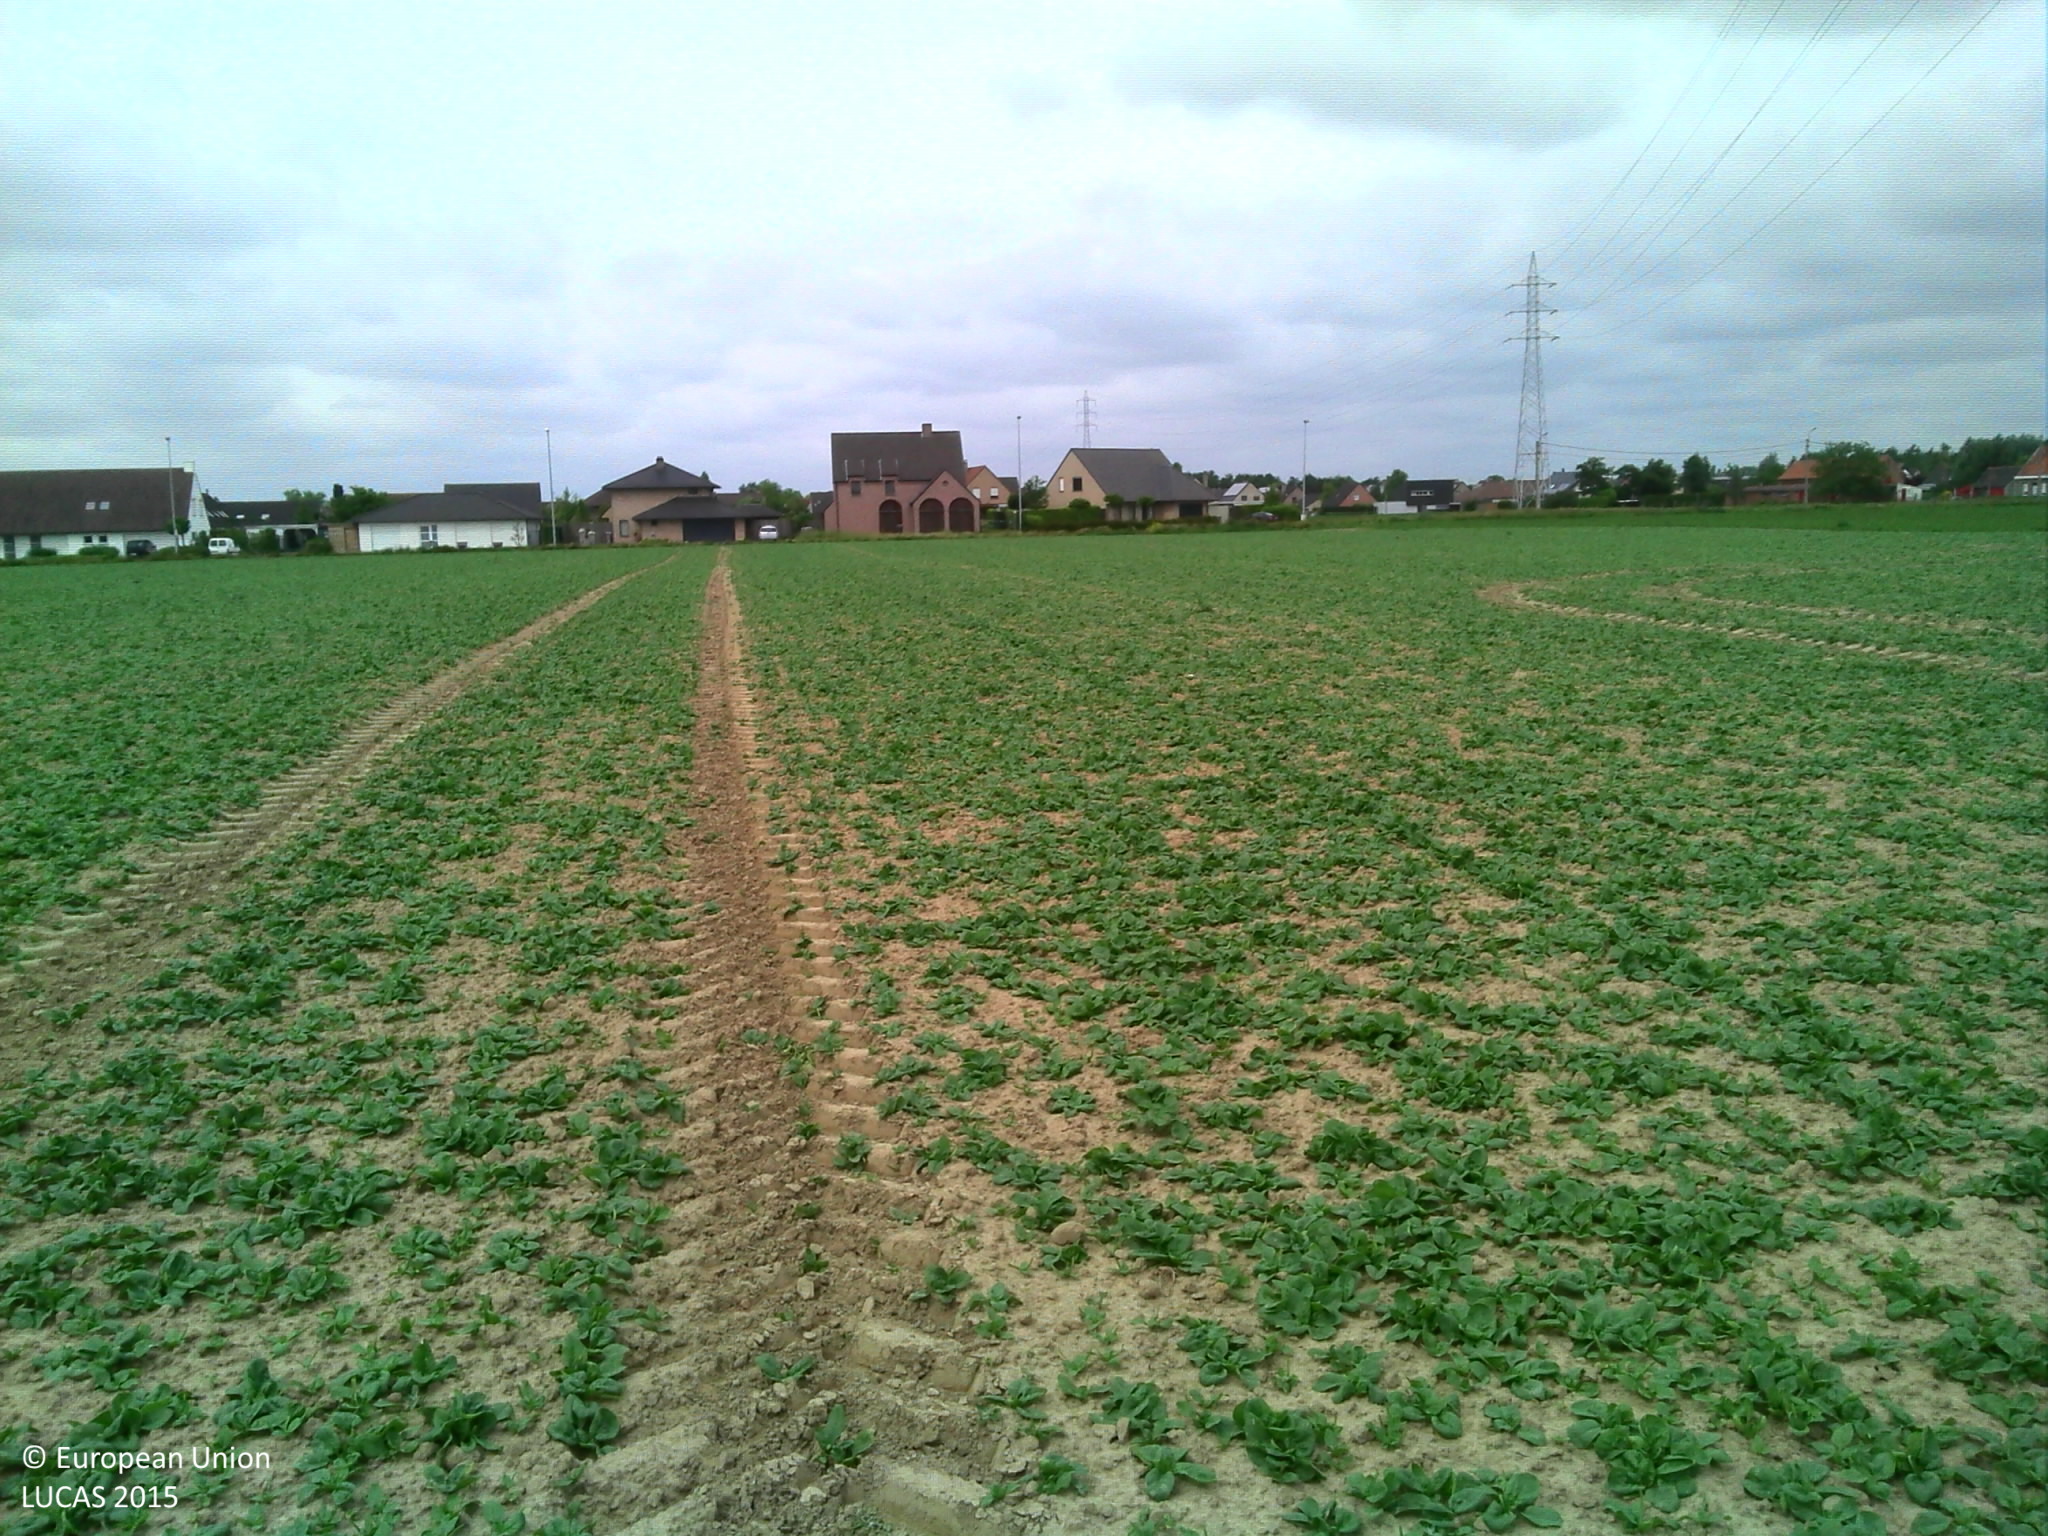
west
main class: Cropland
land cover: Other fresh vegetables
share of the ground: 50 - 75 %
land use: Agriculture (excluding fallow land and kitchen gardens)
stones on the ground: < 10 %
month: June
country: BE
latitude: 50.9685
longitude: 3.1125
